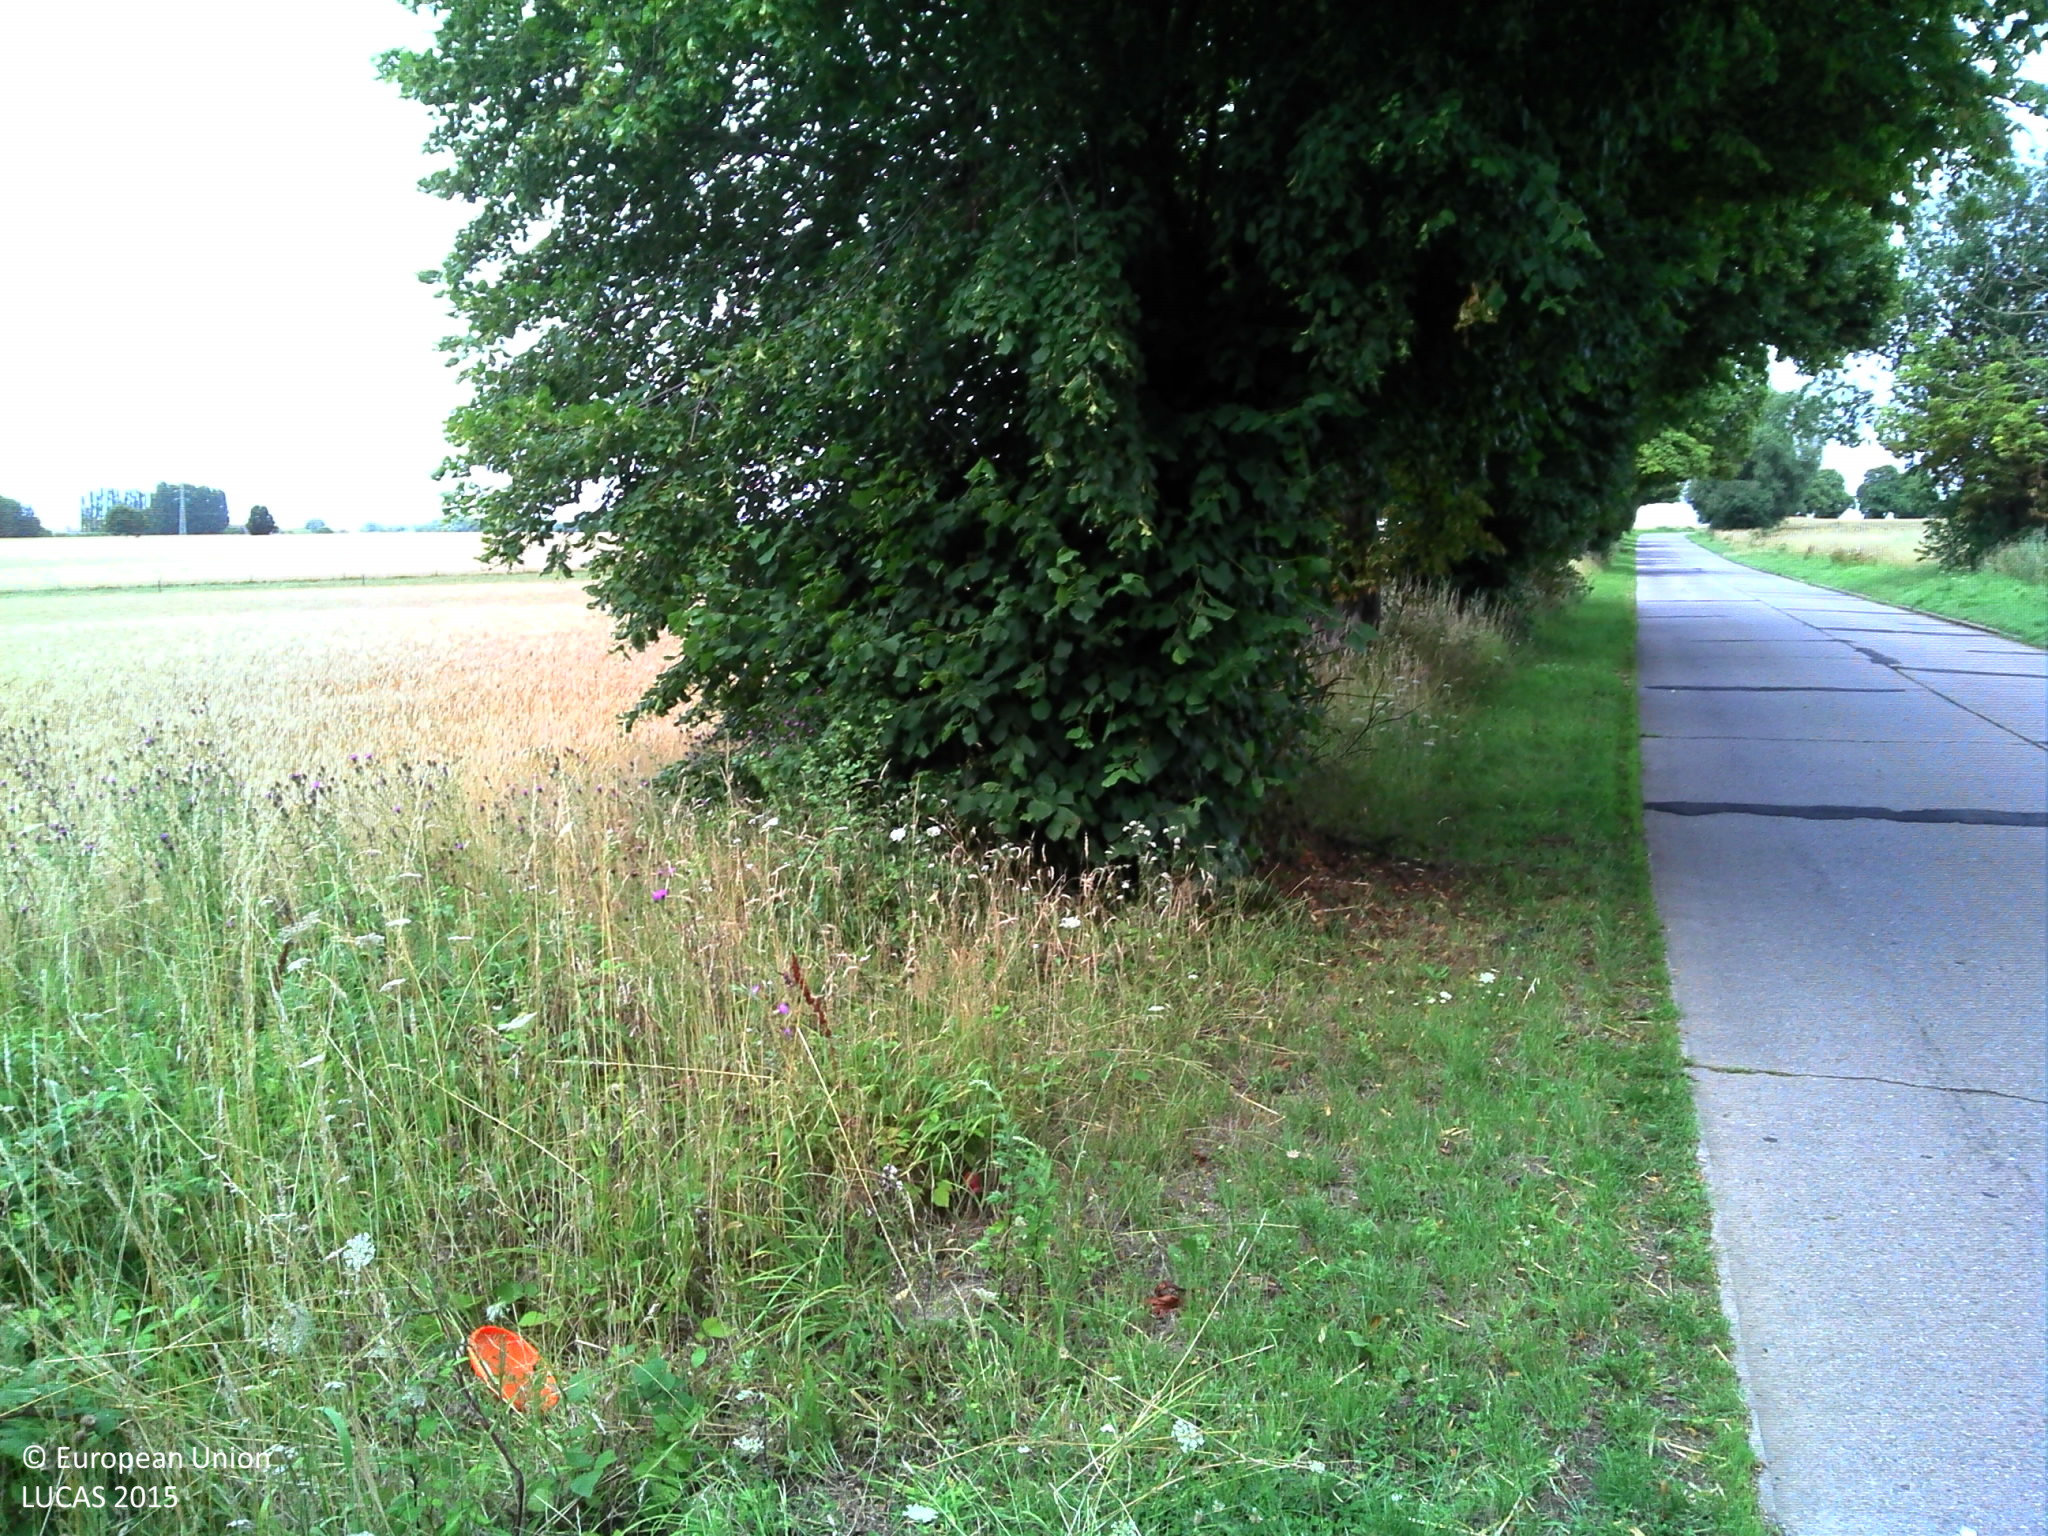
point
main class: Woodland
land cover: Broadleaved woodland
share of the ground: > 75 %
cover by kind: broadleaved forest trees 60 %, herbaceous plants 40 %
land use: Semi-natural and natural areas not in use
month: July
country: BE
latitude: 50.4945
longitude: 4.3426
